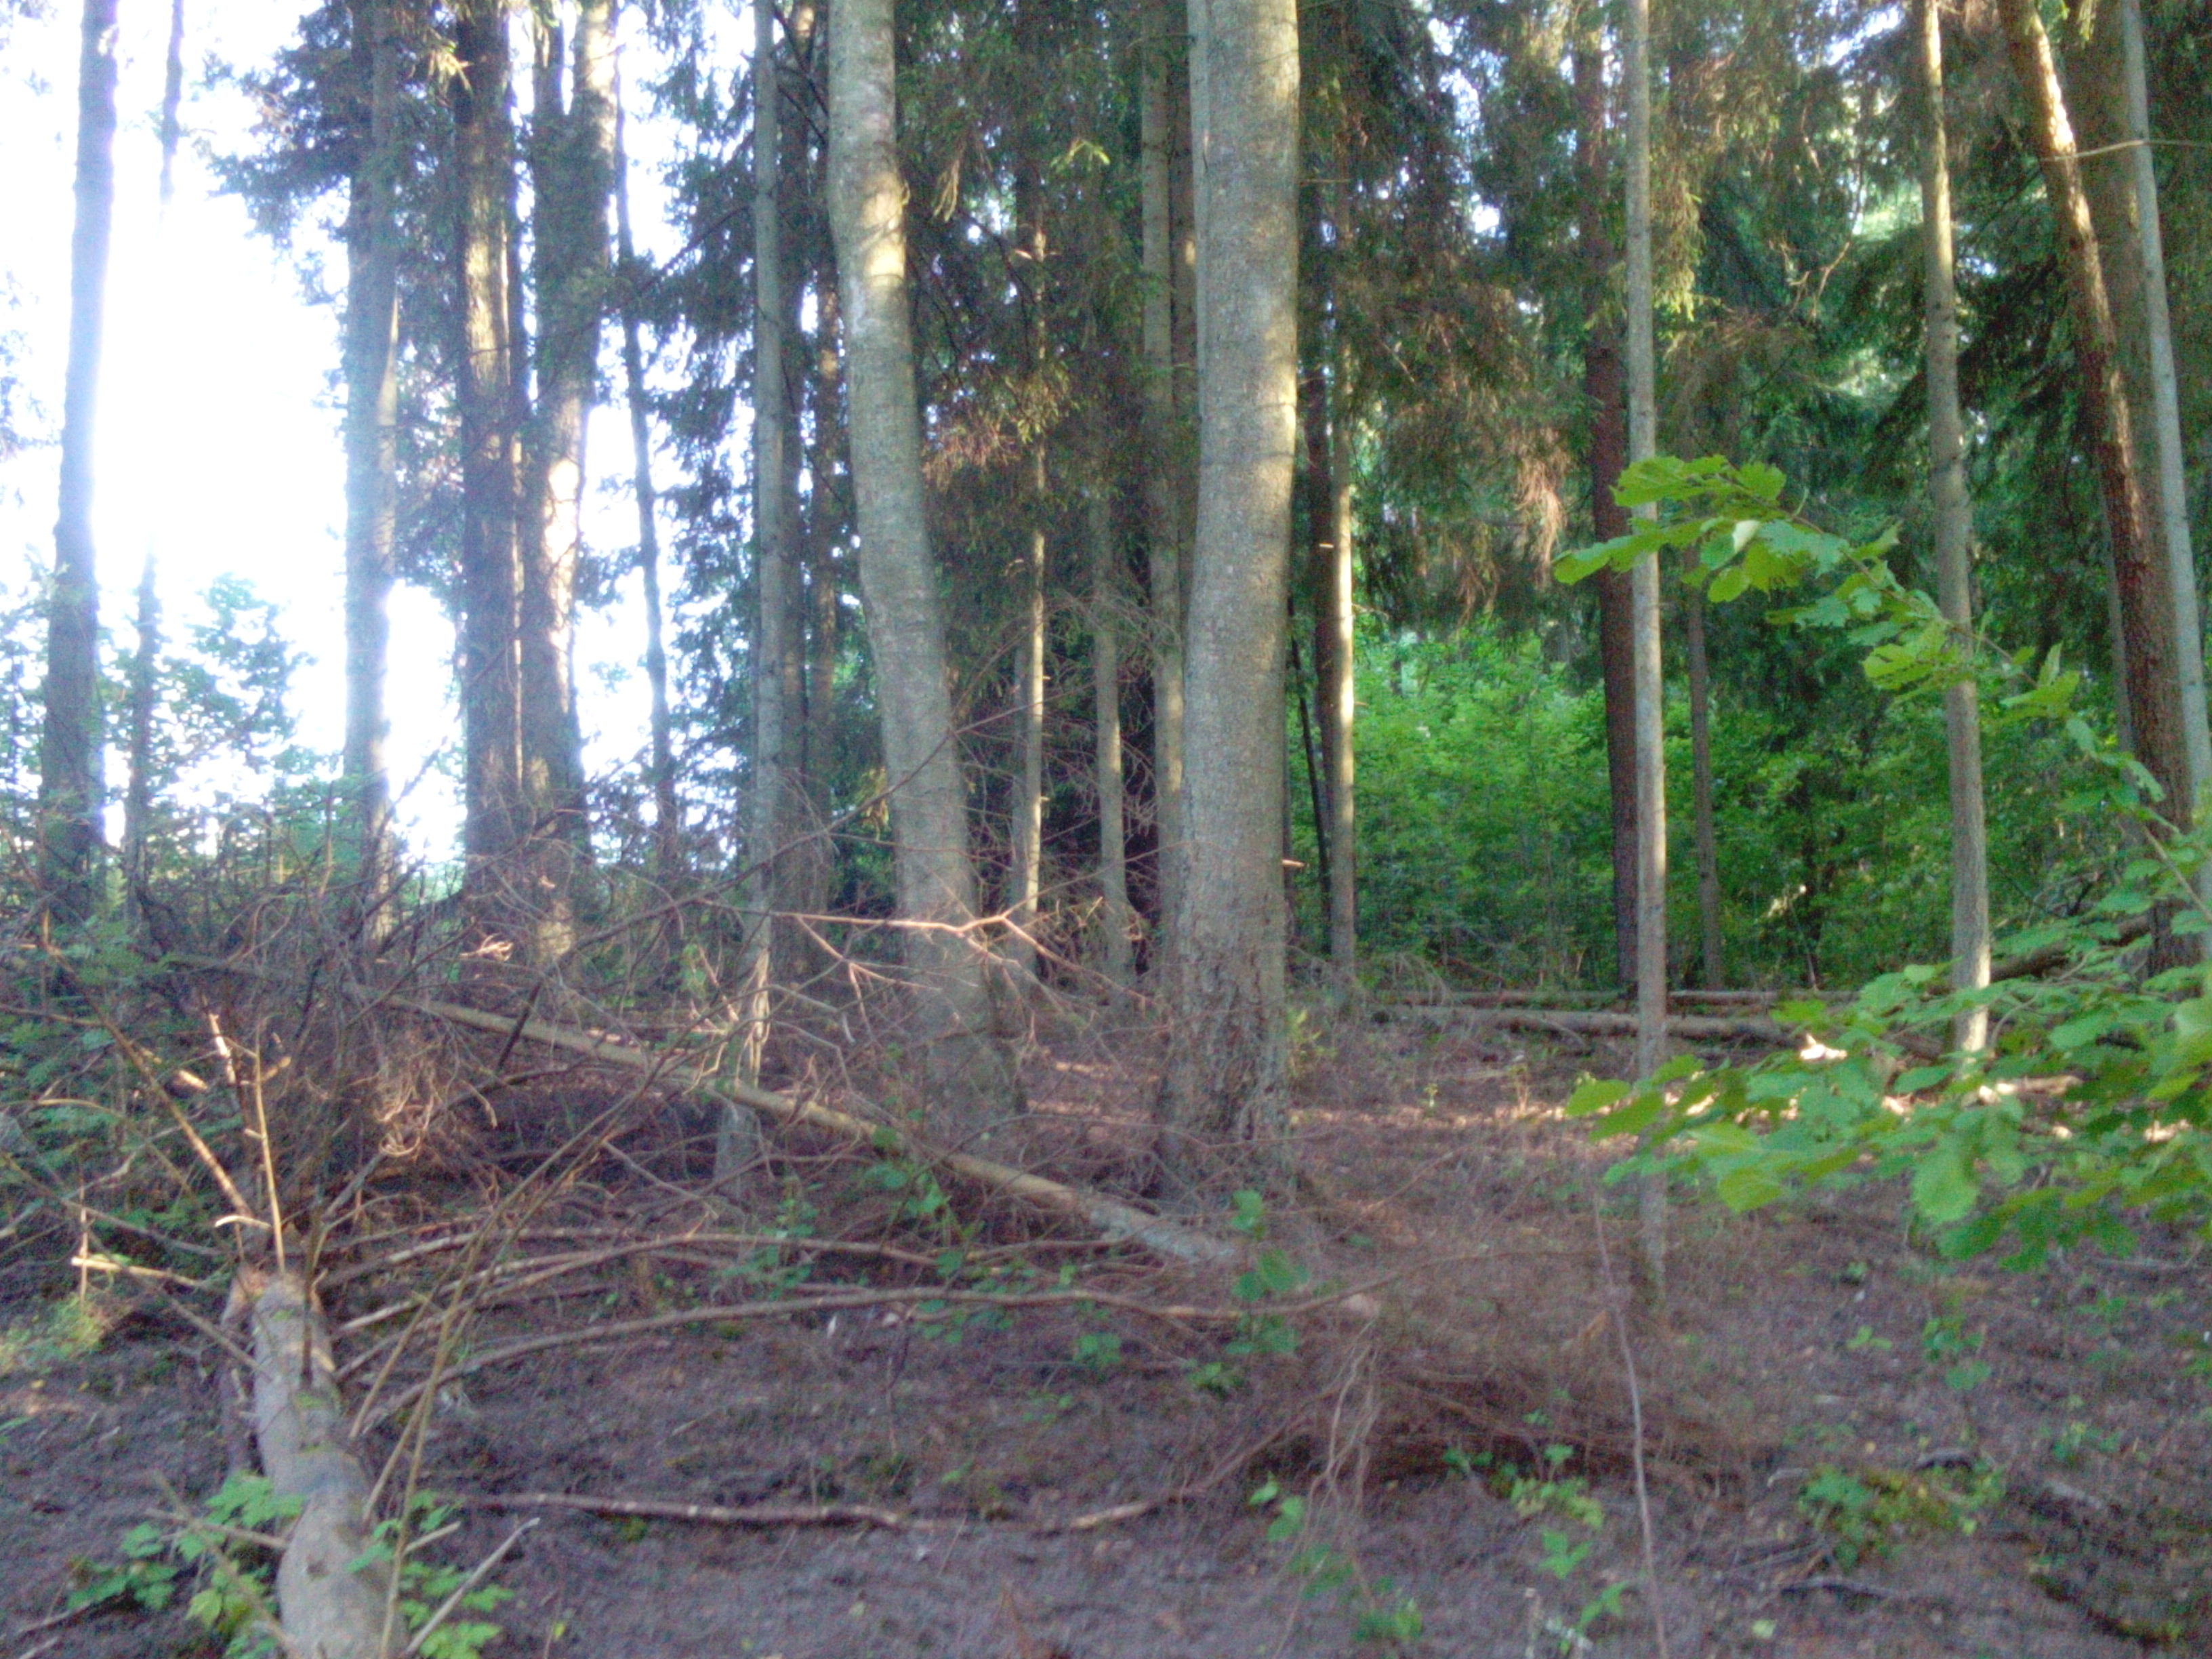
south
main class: Woodland
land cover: Spruce dominated mixed woodland
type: hemiboreal forest and nemoral coniferous forest and mixed broadleaved-coniferous forest
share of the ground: > 75 %
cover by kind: coniferous forest trees 65 %, broadleaved forest trees 25 %, herbaceous plants 5 %, lichens and mosses 5 %
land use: Forestry
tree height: > 5 m
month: July
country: LV
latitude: 56.5056
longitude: 22.0903
